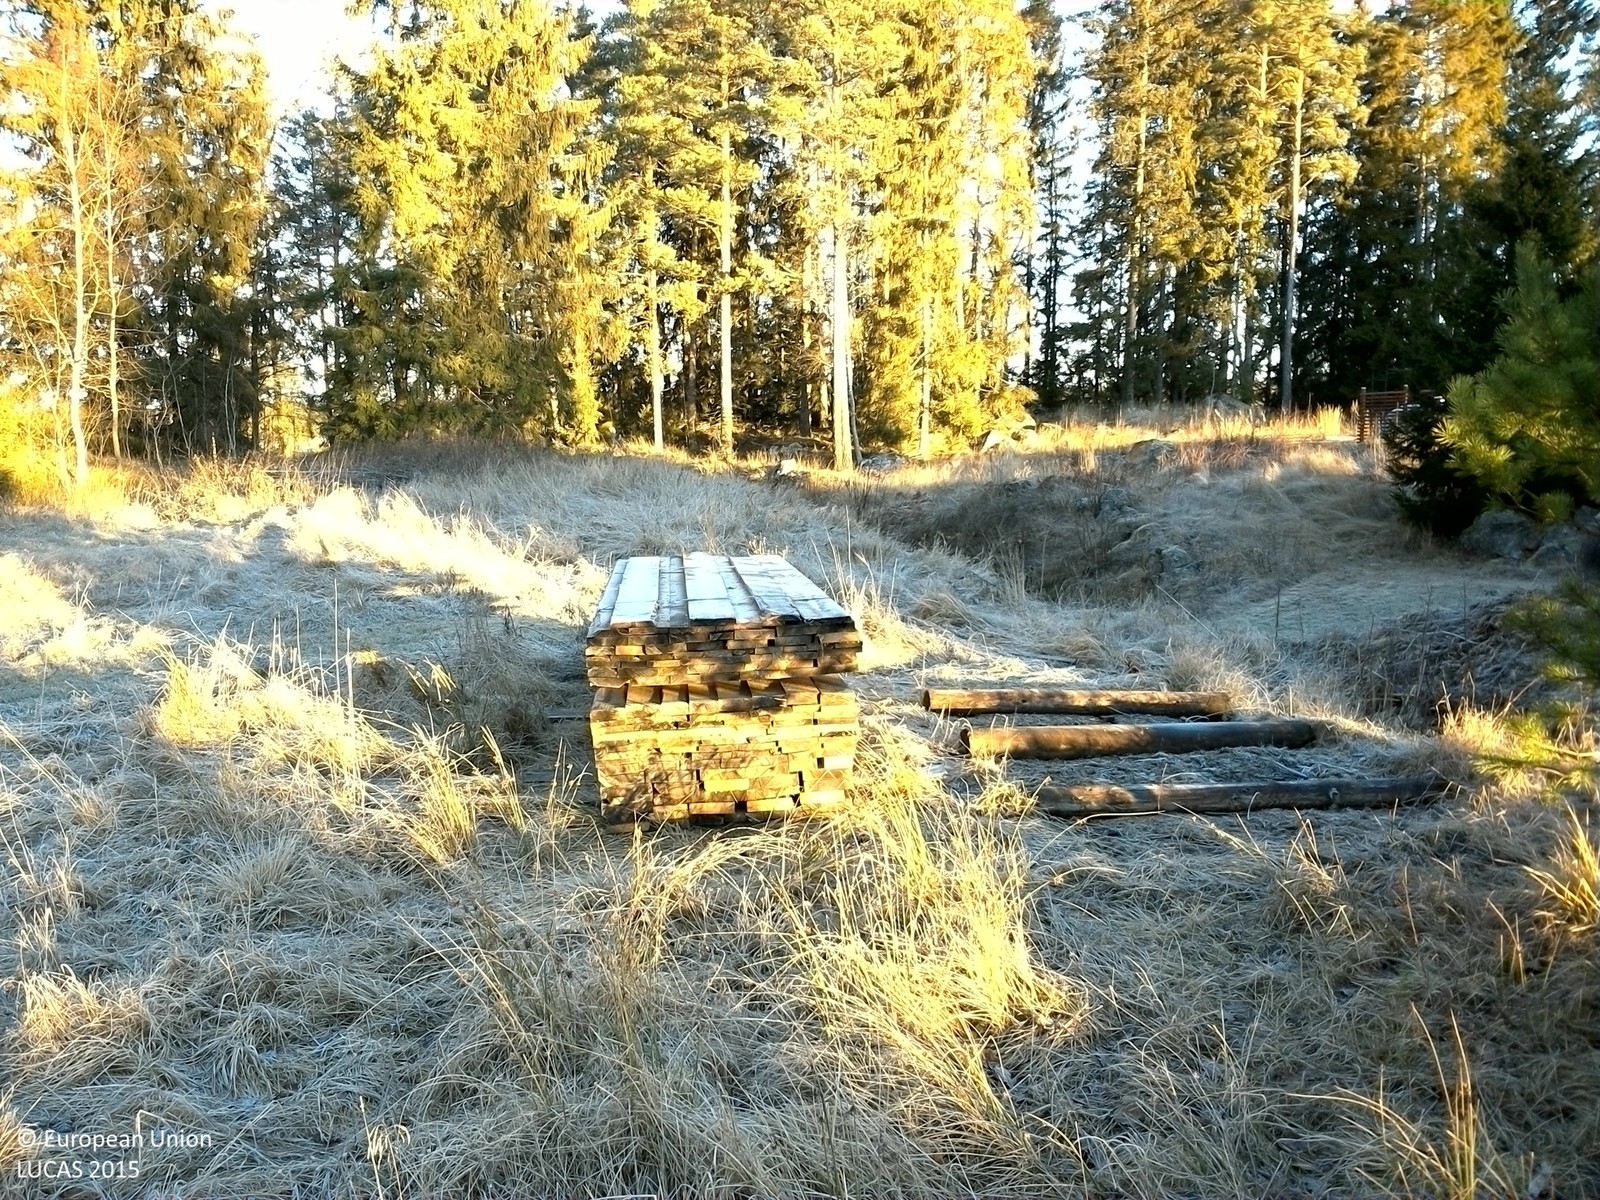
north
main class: Grassland
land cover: Grassland with sparse tree/shrub cover
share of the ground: > 75 %
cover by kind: herbaceous plants 95 %, coniferous forest trees 5 %
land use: Residential
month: December
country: SE
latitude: 59.3354
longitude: 16.3035
